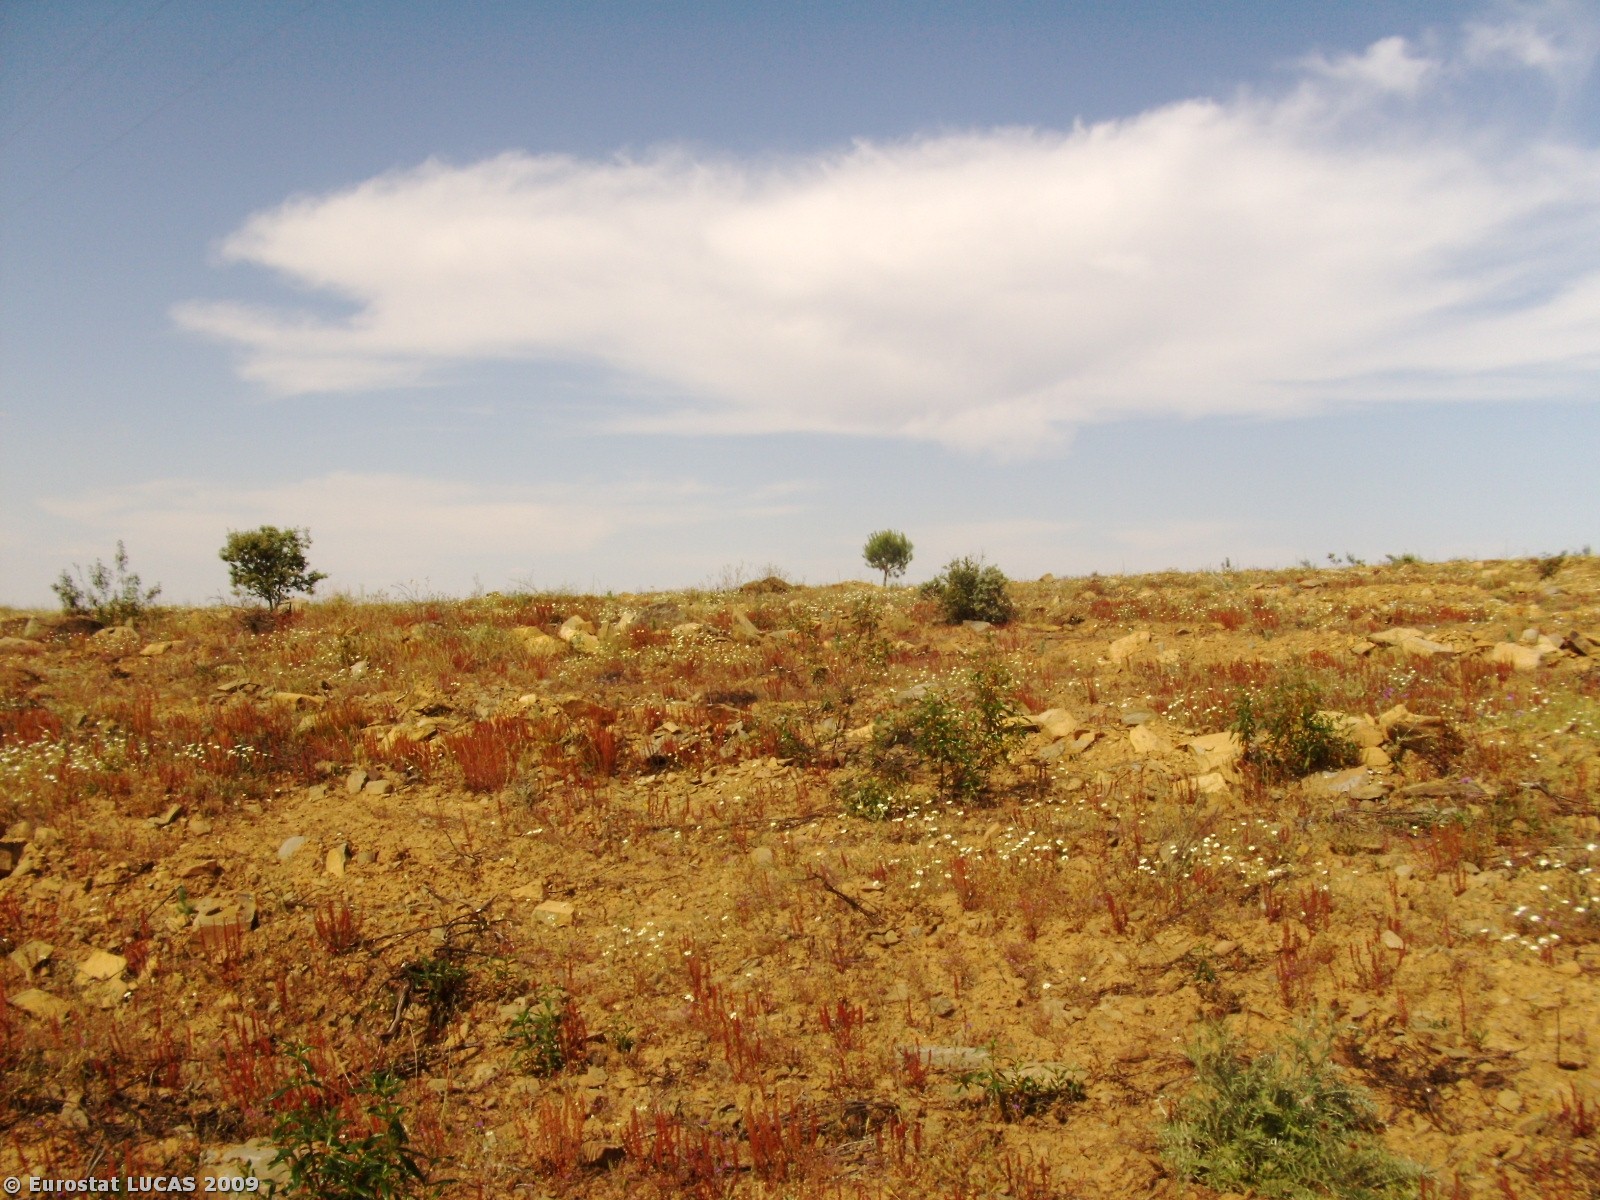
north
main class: Woodland
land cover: Coniferous woodland
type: coniferous forest of the mediterranean region
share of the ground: 10 - 25 %
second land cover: Bare land
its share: > 75 %
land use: Forestry
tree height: > 5 m
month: May
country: PT
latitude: 37.4543
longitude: -7.6352
